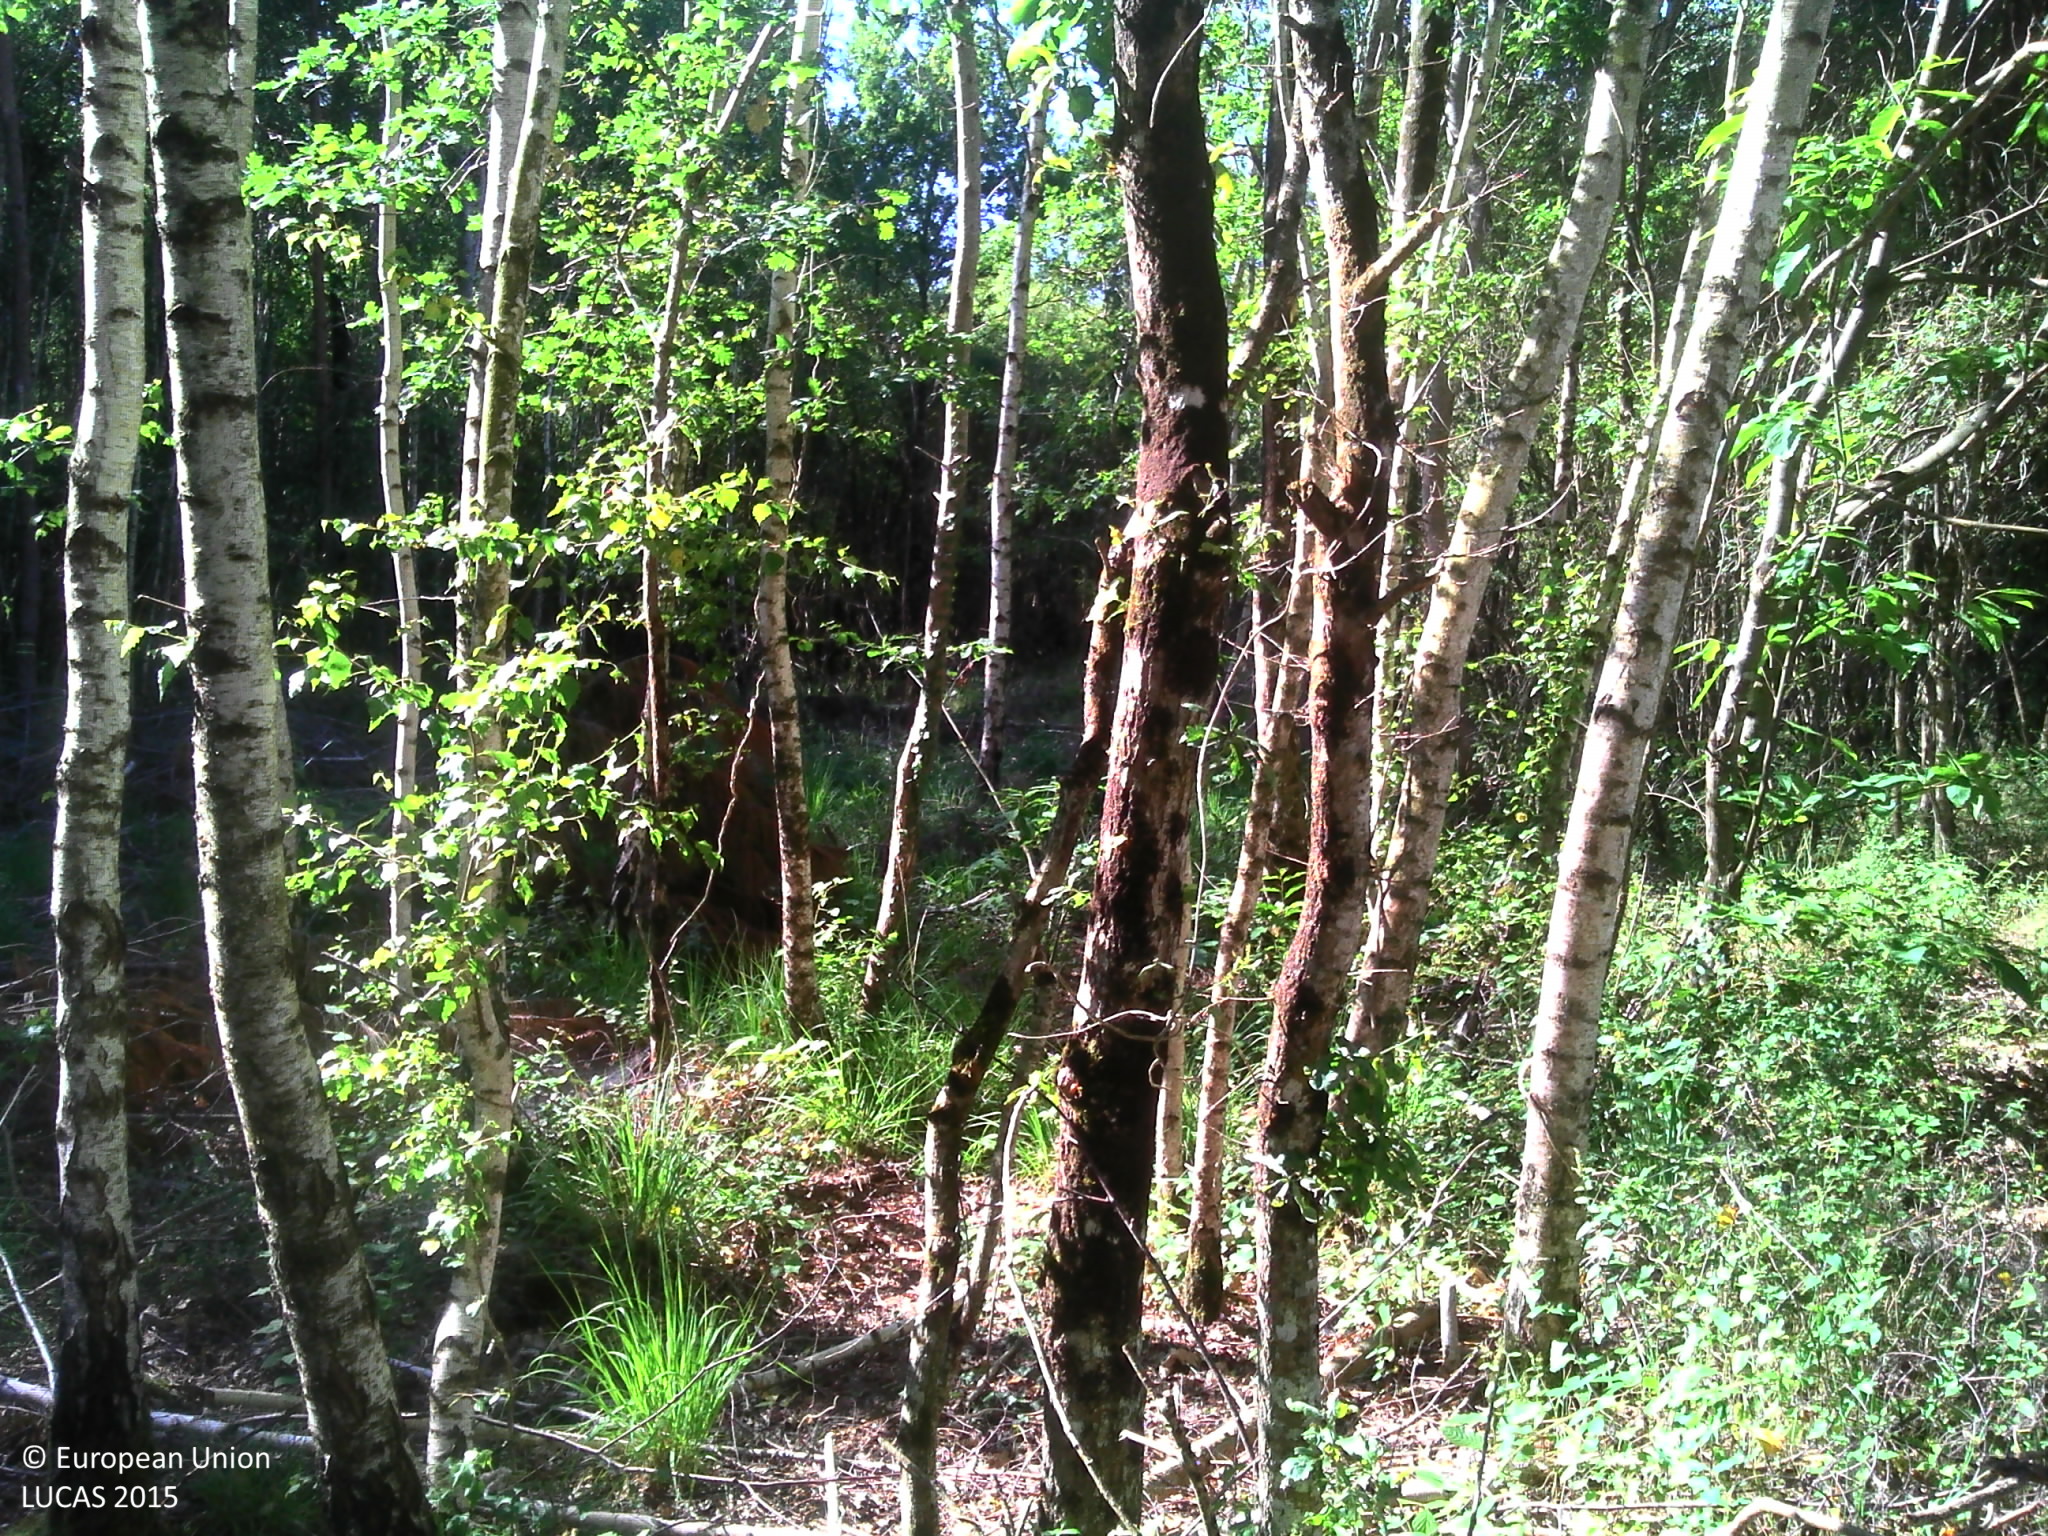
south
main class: Woodland
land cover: Broadleaved woodland
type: mesophytic deciduous forest
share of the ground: > 75 %
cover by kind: broadleaved forest trees 75 %, shrubs 10 %, coniferous forest trees 5 %, herbaceous plants 5 %, lichens and mosses 5 %
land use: Forestry
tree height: > 5 m
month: June
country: FR
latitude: 47.4001
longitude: 0.3447
